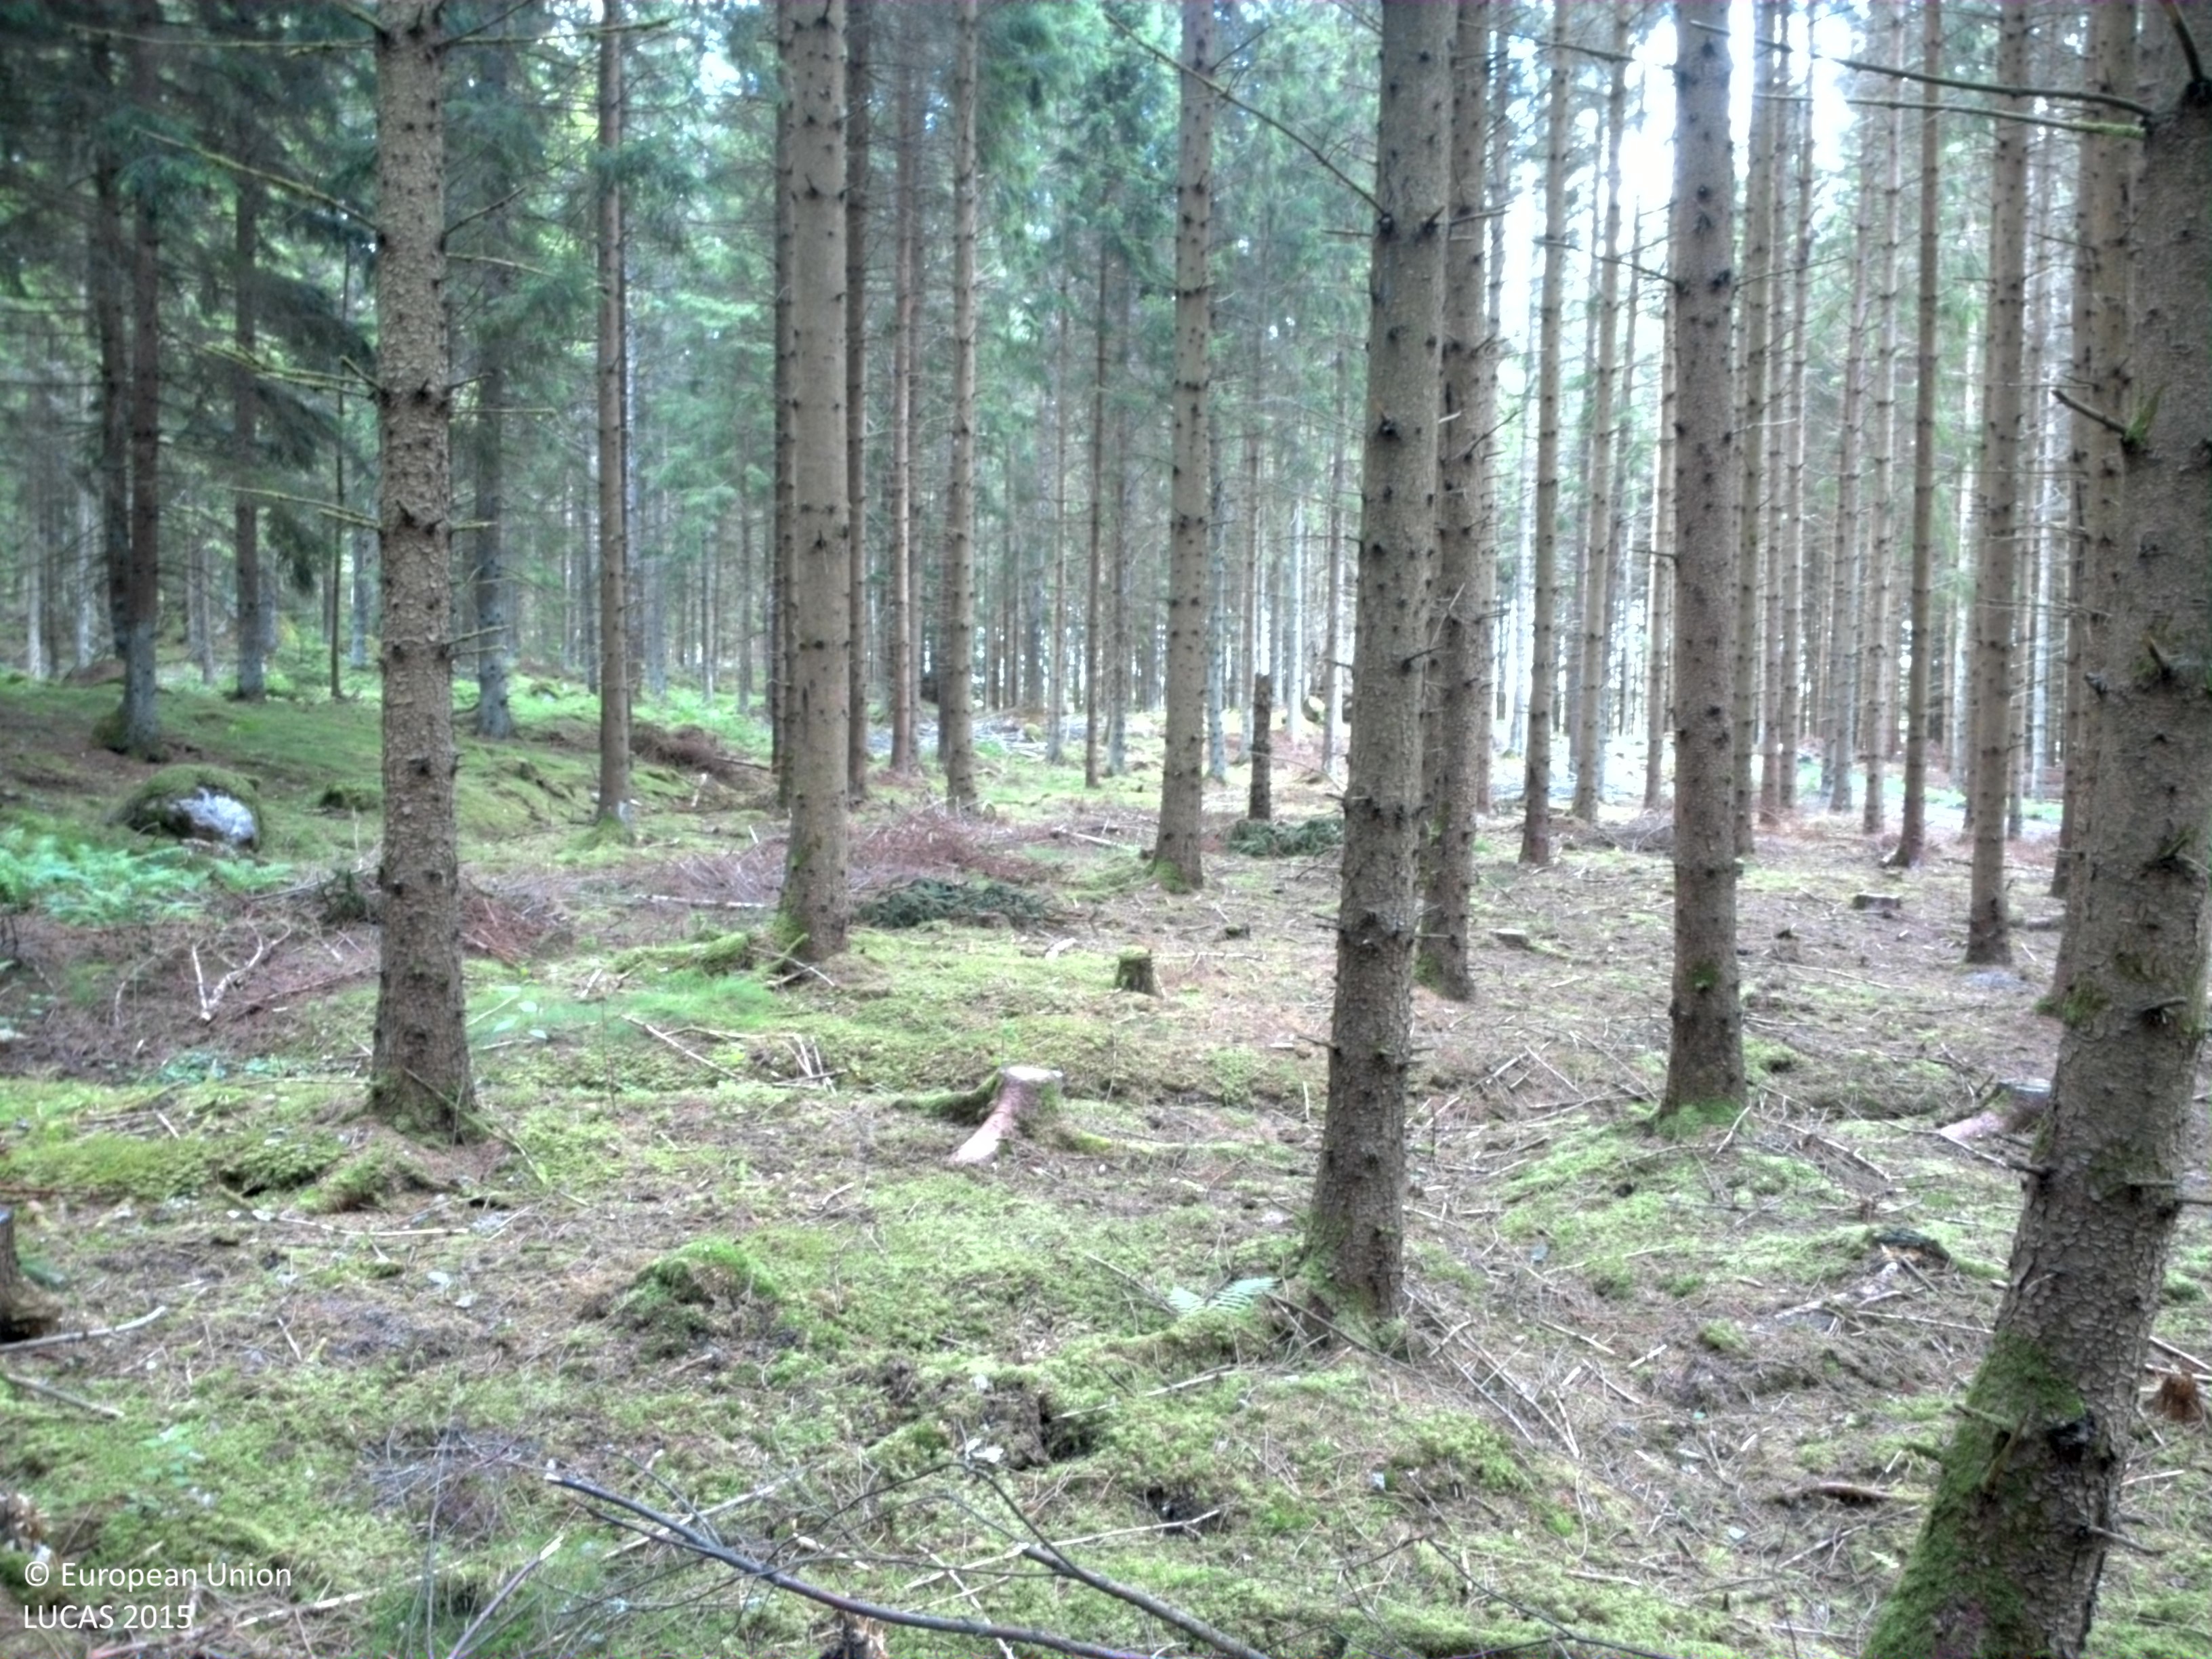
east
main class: Woodland
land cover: Spruce dominated coniferous woodland
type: boreal forest
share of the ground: 50 - 75 %
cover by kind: coniferous forest trees 75 %, lichens and mosses 10 %, unconsolidated bare surface 10 %, herbaceous plants 5 %
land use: Forestry
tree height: > 5 m
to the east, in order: Spruce dominated coniferous woodland; Ditches and canals; Spruce dominated coniferous woodland; Ditches and canals; Spruce dominated coniferous woodland; Spruce dominated mixed woodland; Spruce dominated coniferous woodland; Ditches and canals; Spruce dominated coniferous woodland; Ditches and canals; Tracks; Spruce dominated coniferous woodland; Ditches and canals; Spruce dominated coniferous woodland; Spruce dominated mixed woodland; Inland marshes
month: July
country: SE
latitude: 58.7180
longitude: 14.0161
